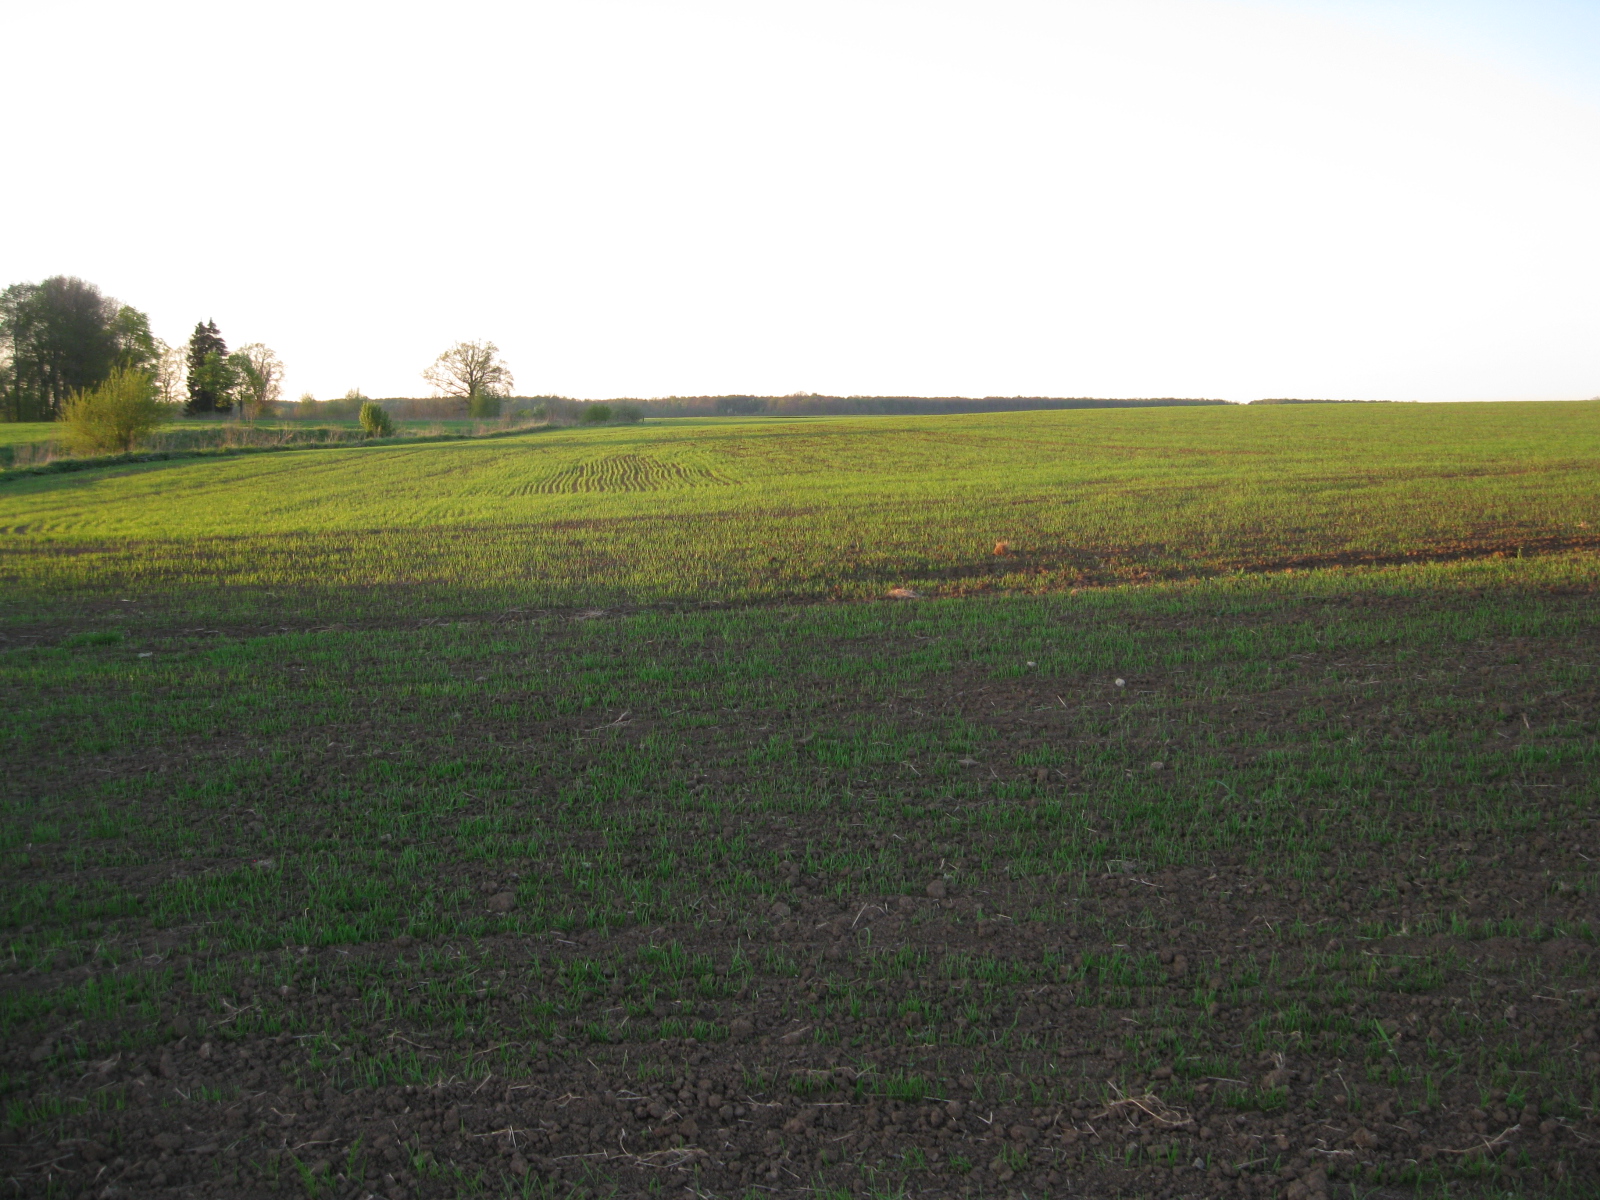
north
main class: Cropland
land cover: Common wheat
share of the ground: < 10 %
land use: Agriculture (excluding fallow land and kitchen gardens)
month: May
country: LT
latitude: 56.1168
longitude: 24.4263
